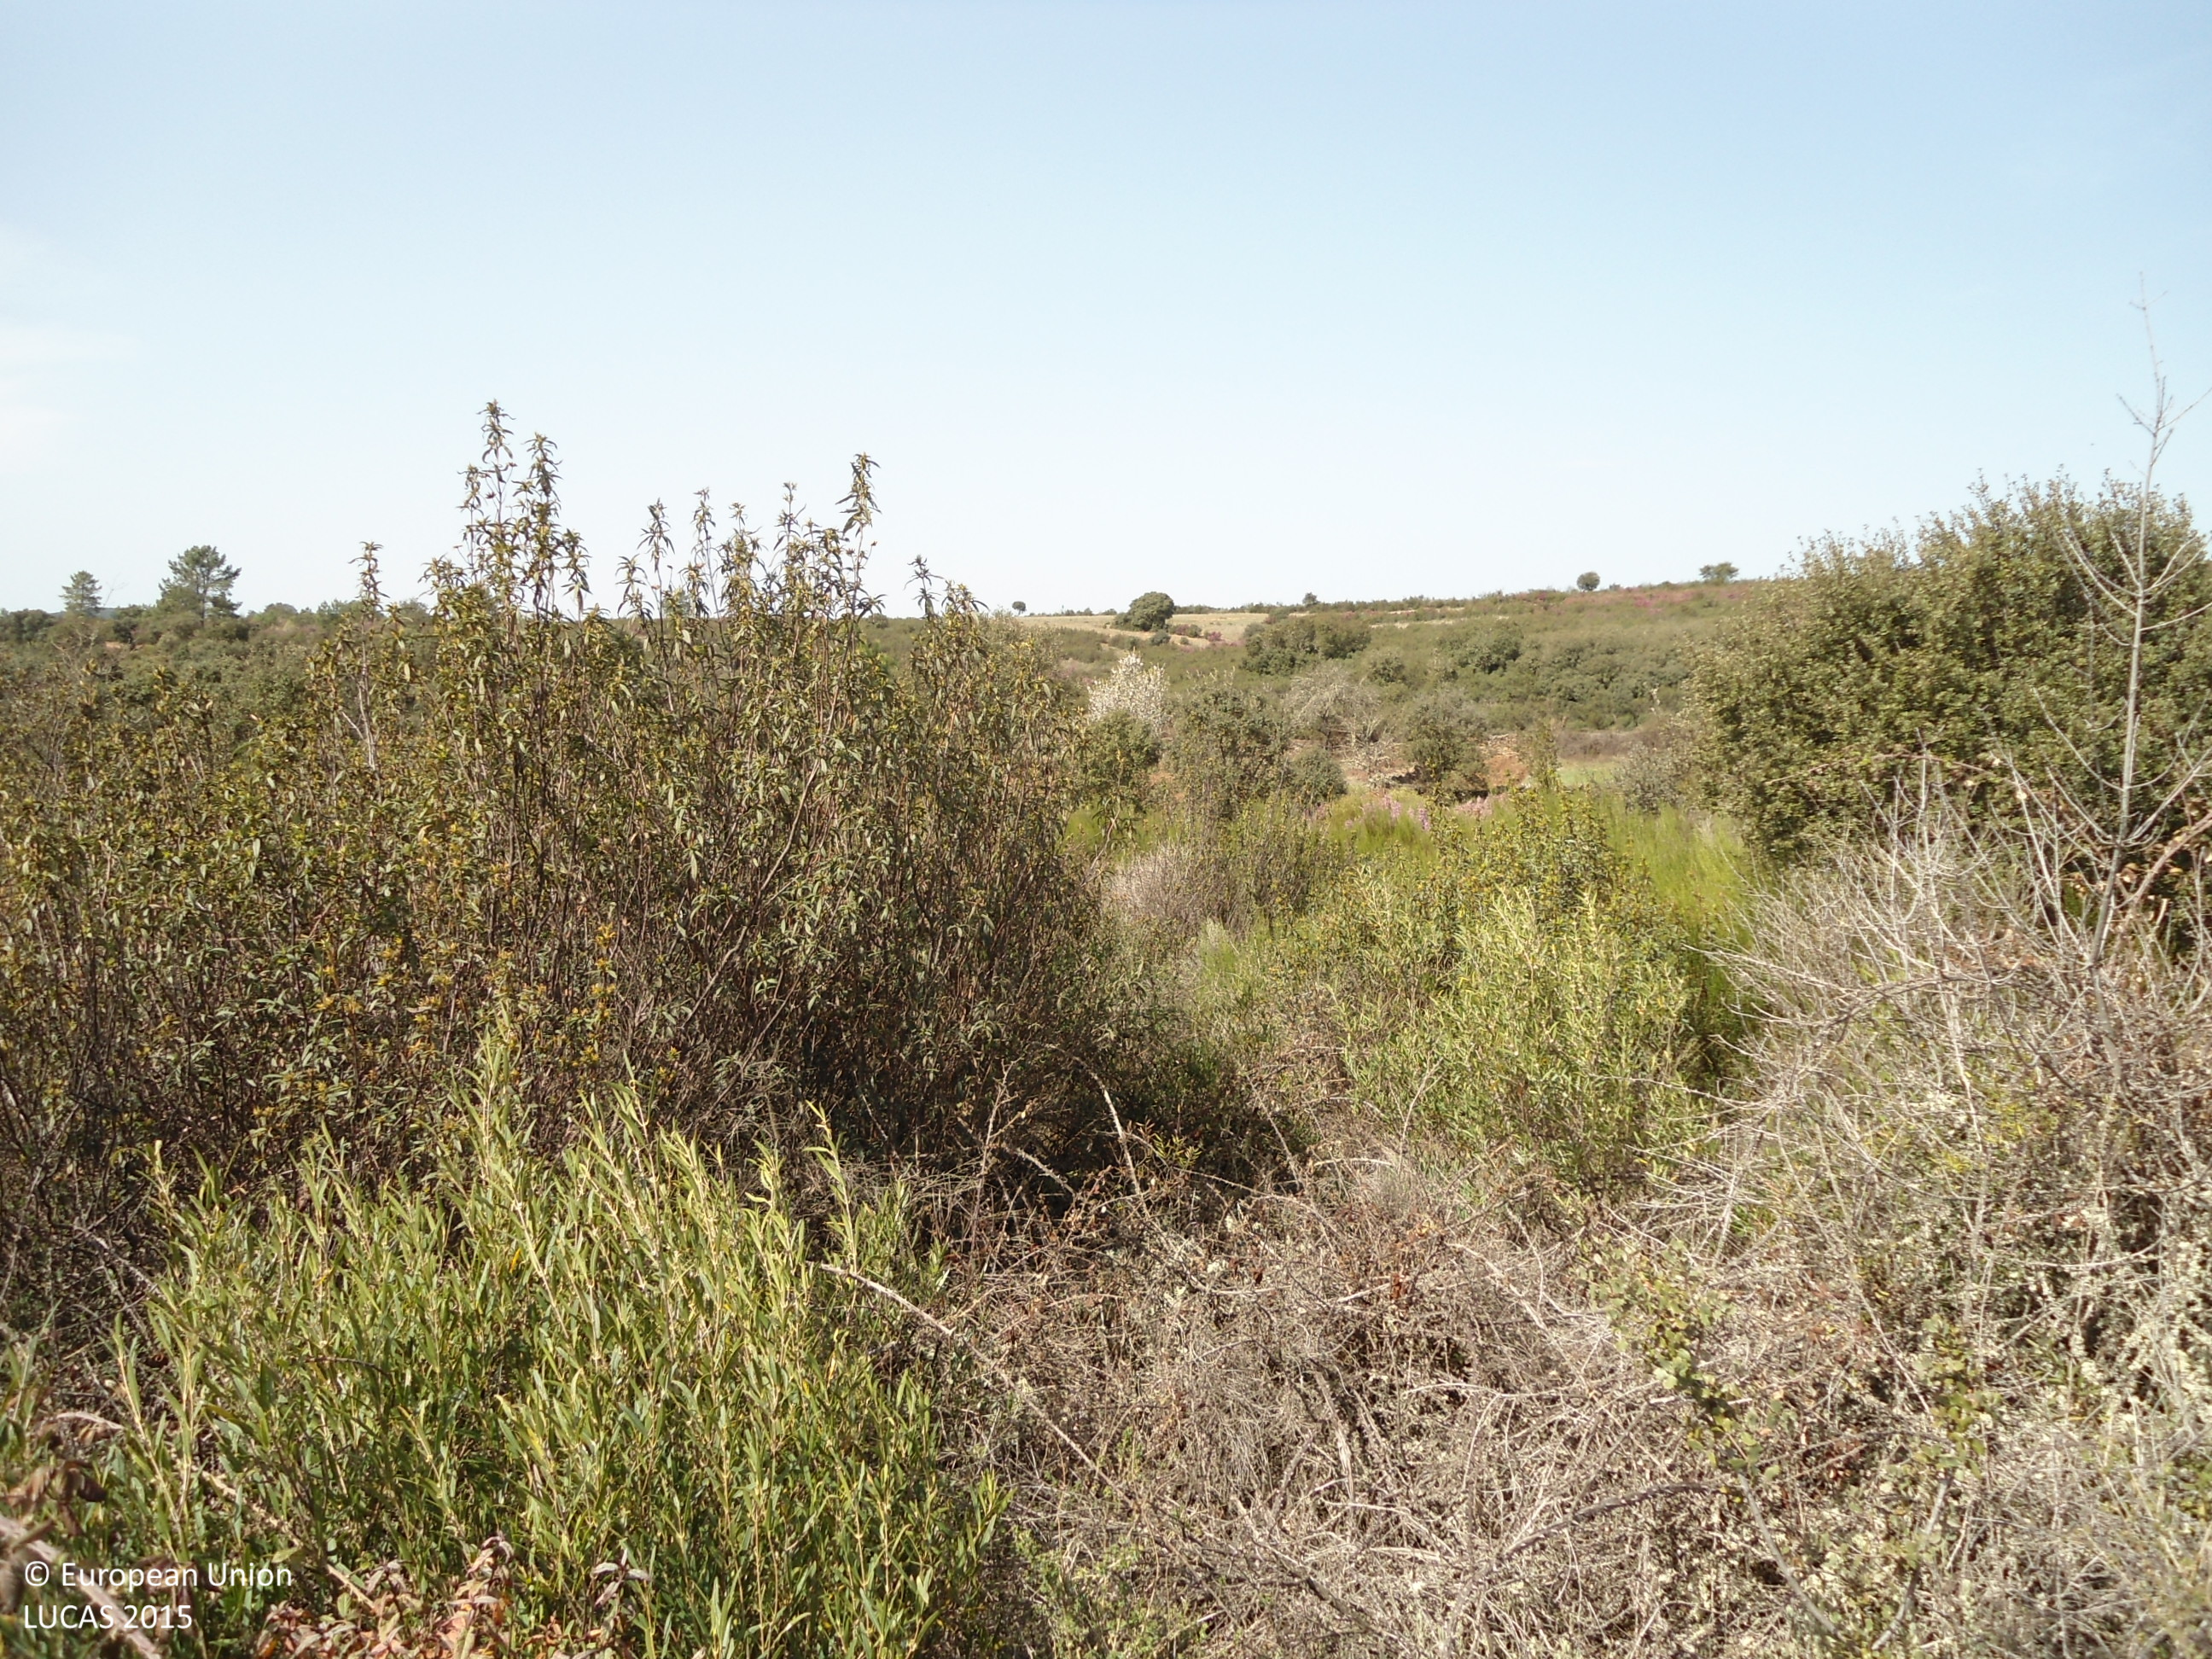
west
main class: Shrubland
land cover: Shrubland without tree cover
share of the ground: > 75 %
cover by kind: shrubs 90 %, herbaceous plants 10 %
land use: Semi-natural and natural areas not in use
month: April
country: ES
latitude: 41.7013
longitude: -6.4595
